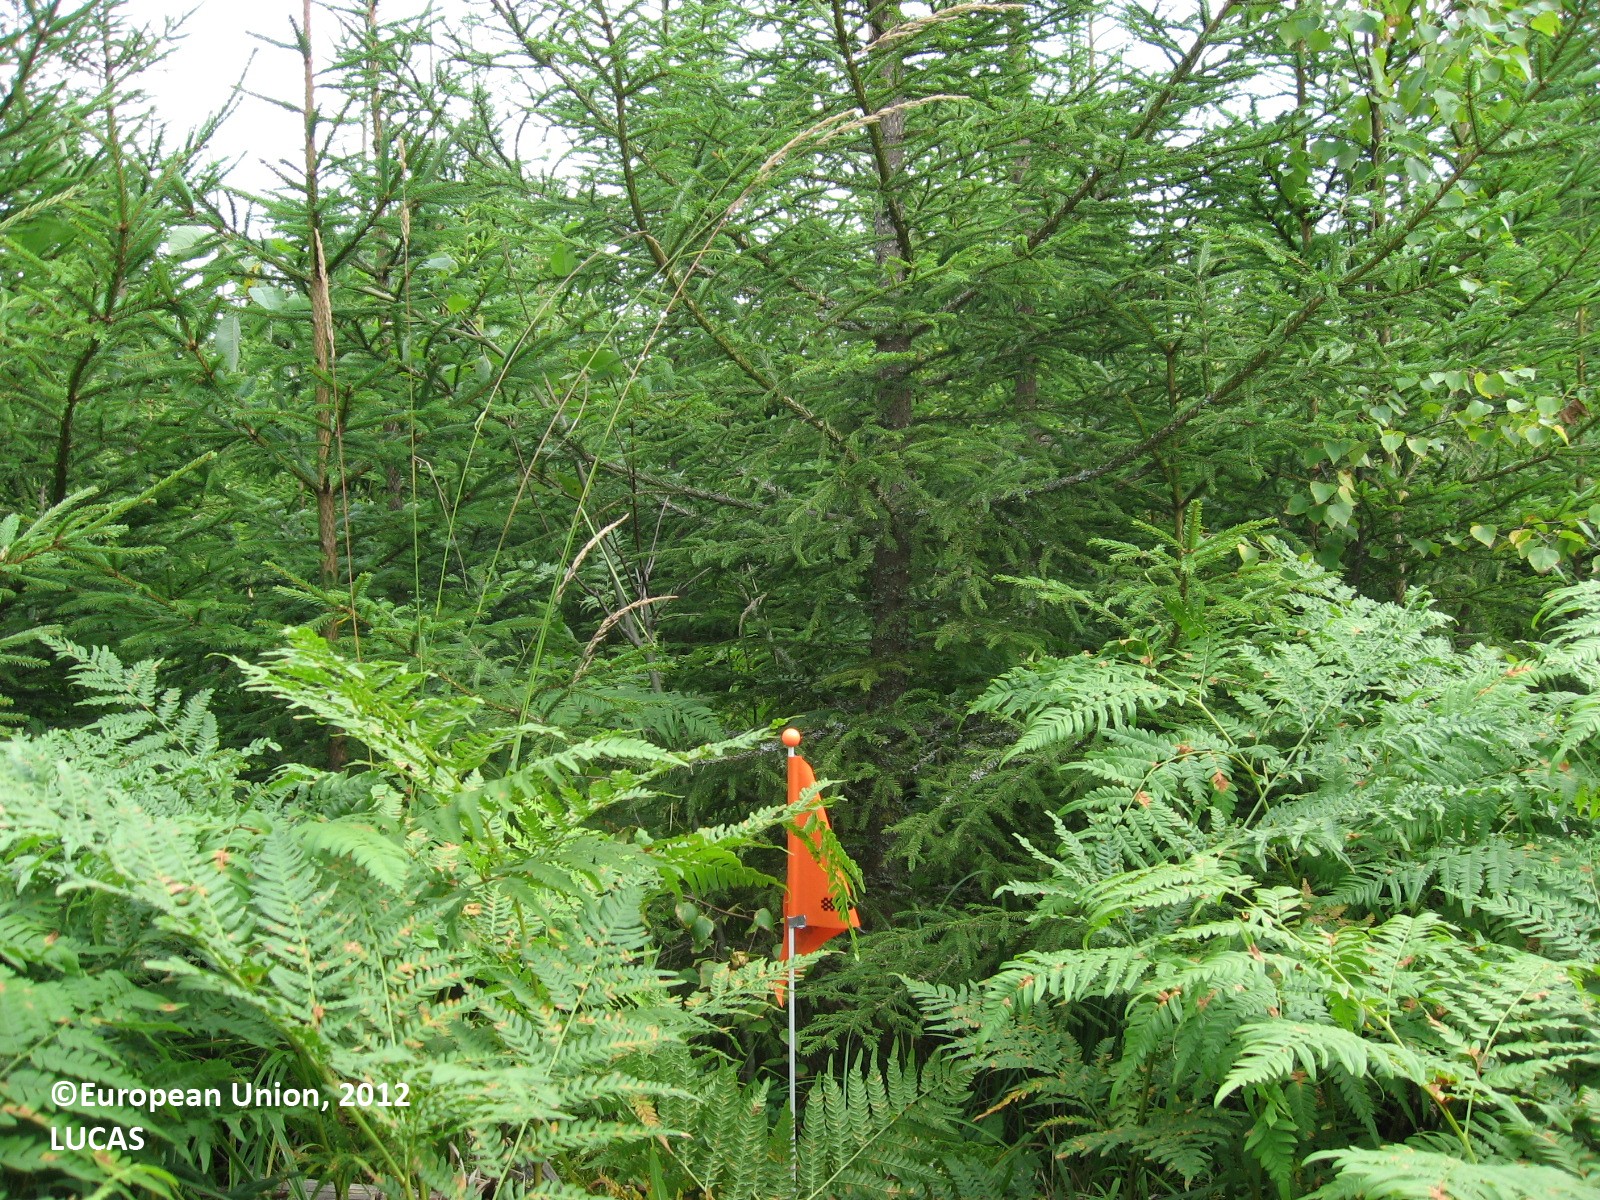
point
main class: Woodland
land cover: Spruce dominated mixed woodland
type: boreal forest
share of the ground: > 75 %
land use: Forestry
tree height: < 5 m
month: August
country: FI
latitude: 61.2271
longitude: 24.8396
